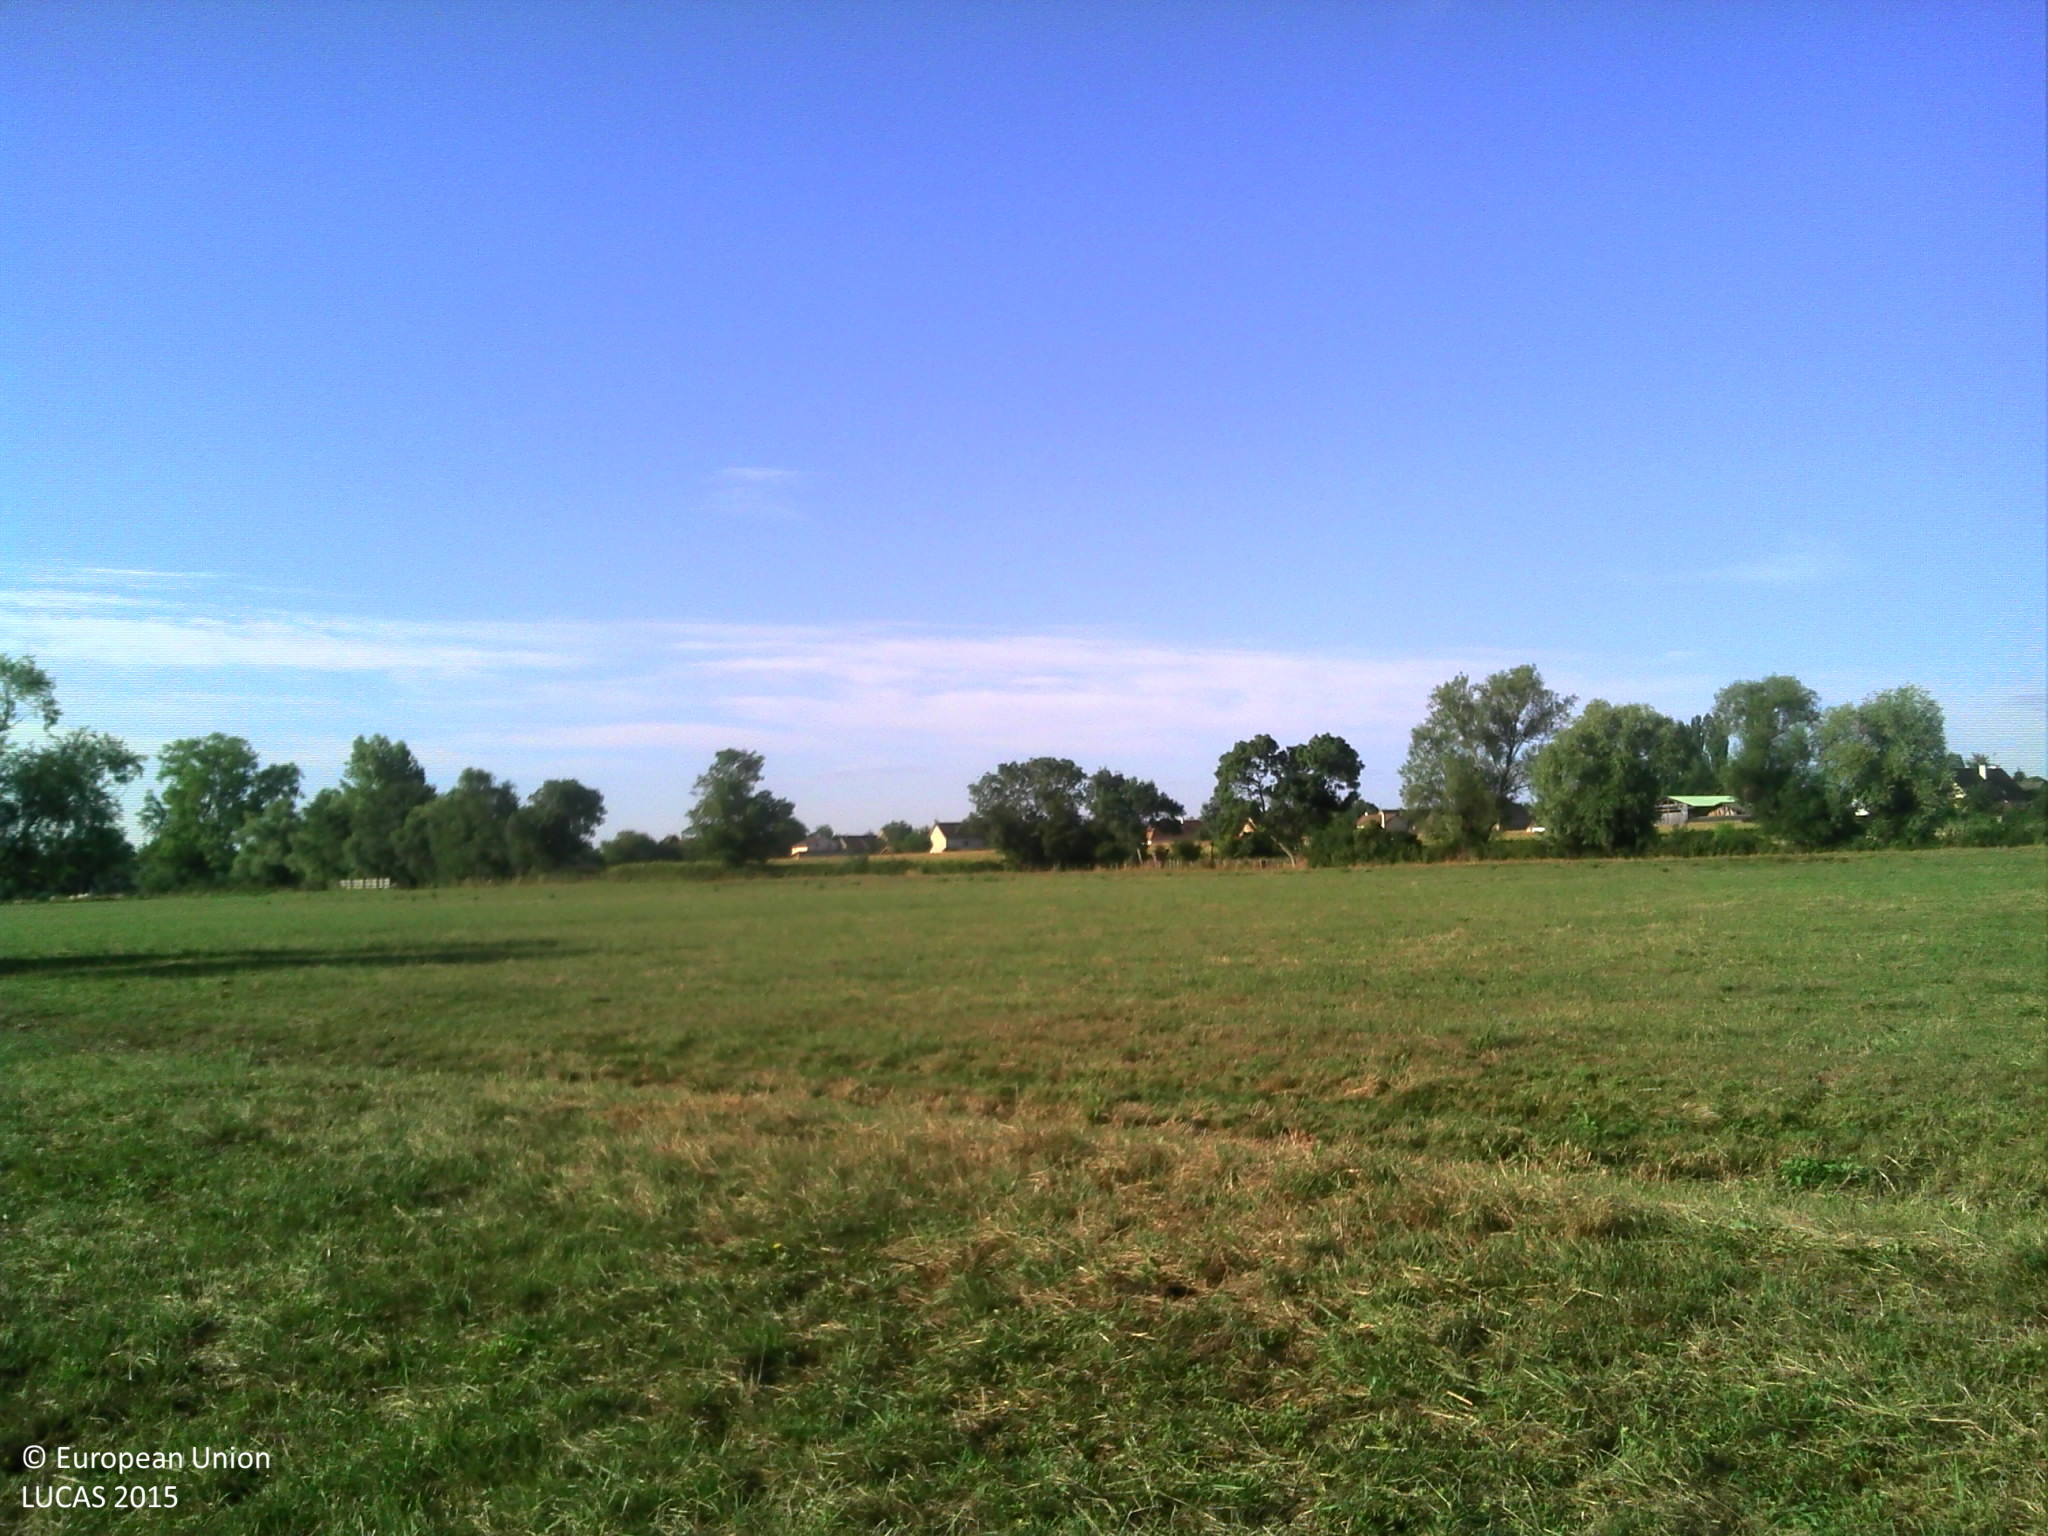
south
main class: Grassland
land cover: Grassland without tree/shrub cover
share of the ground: > 75 %
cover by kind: herbaceous plants 100 %
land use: Agriculture (excluding fallow land and kitchen gardens)
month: July
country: FR
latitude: 46.7161
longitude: 4.8864
